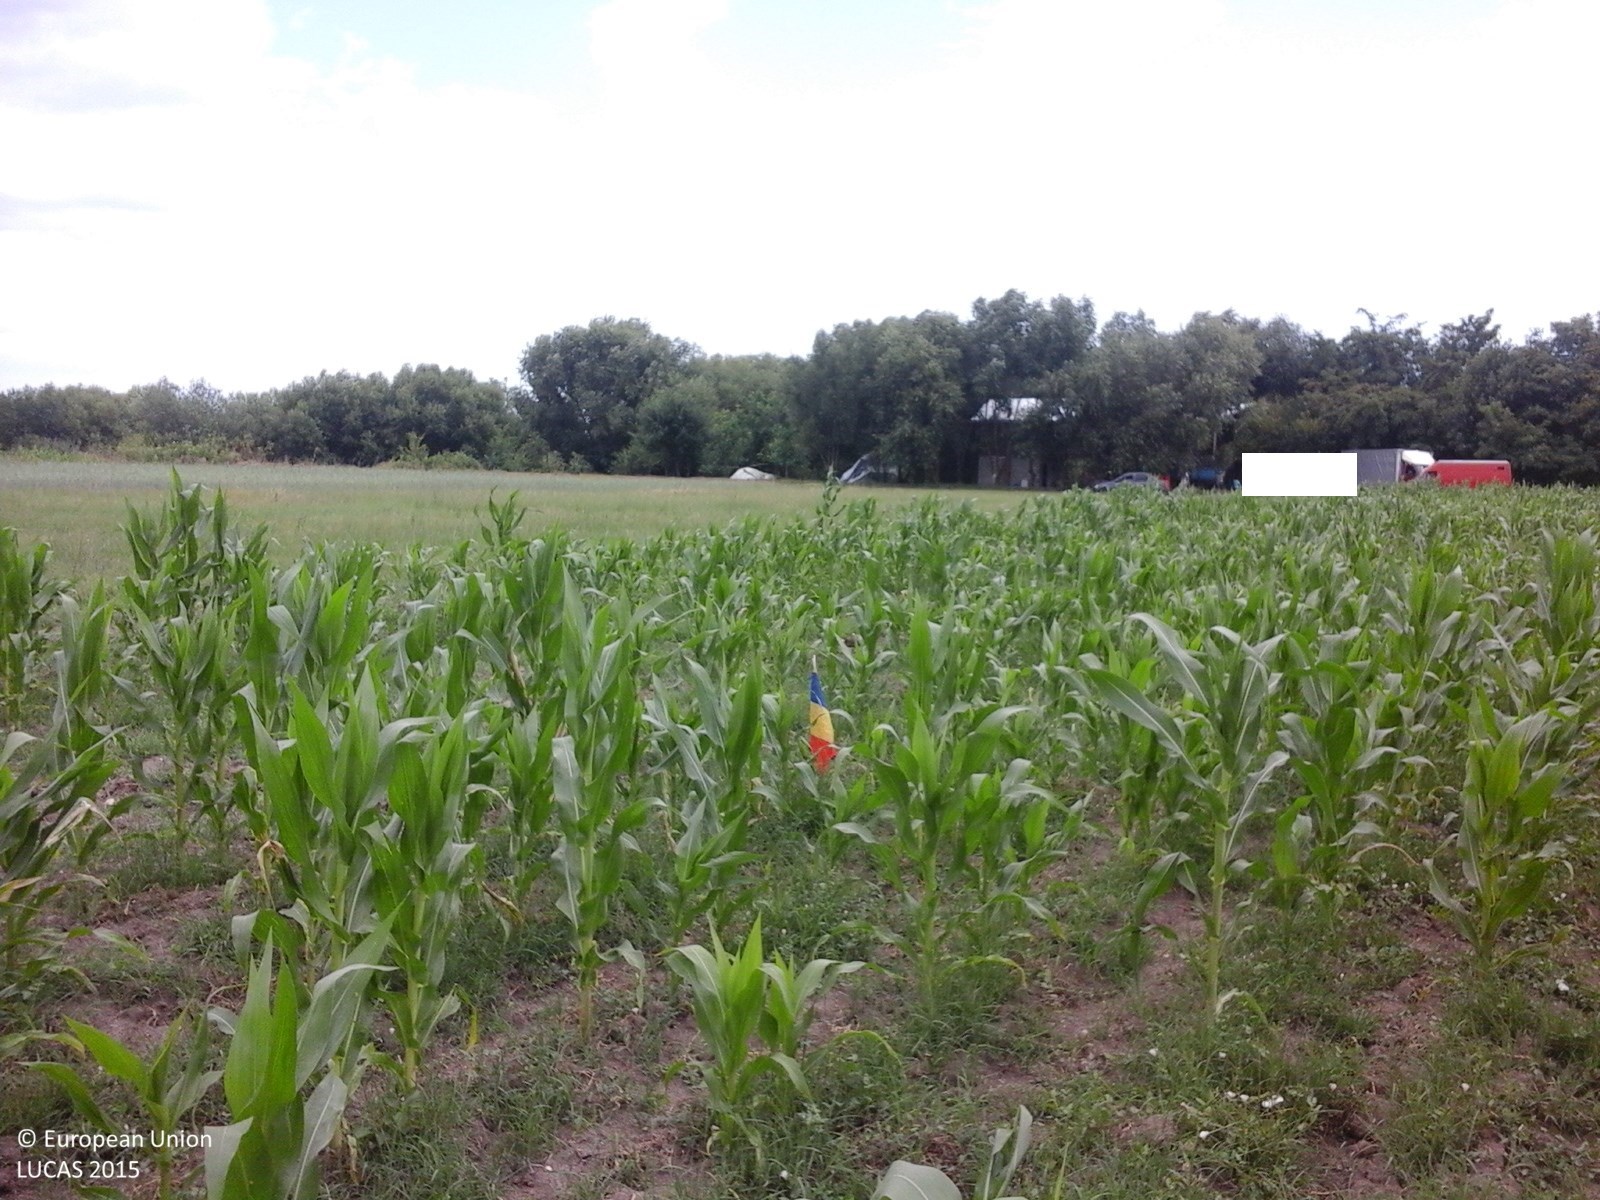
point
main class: Cropland
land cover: Maize
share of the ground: 50 - 75 %
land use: Agriculture (excluding fallow land and kitchen gardens)
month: July
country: RO
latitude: 44.3989
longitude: 25.5474
